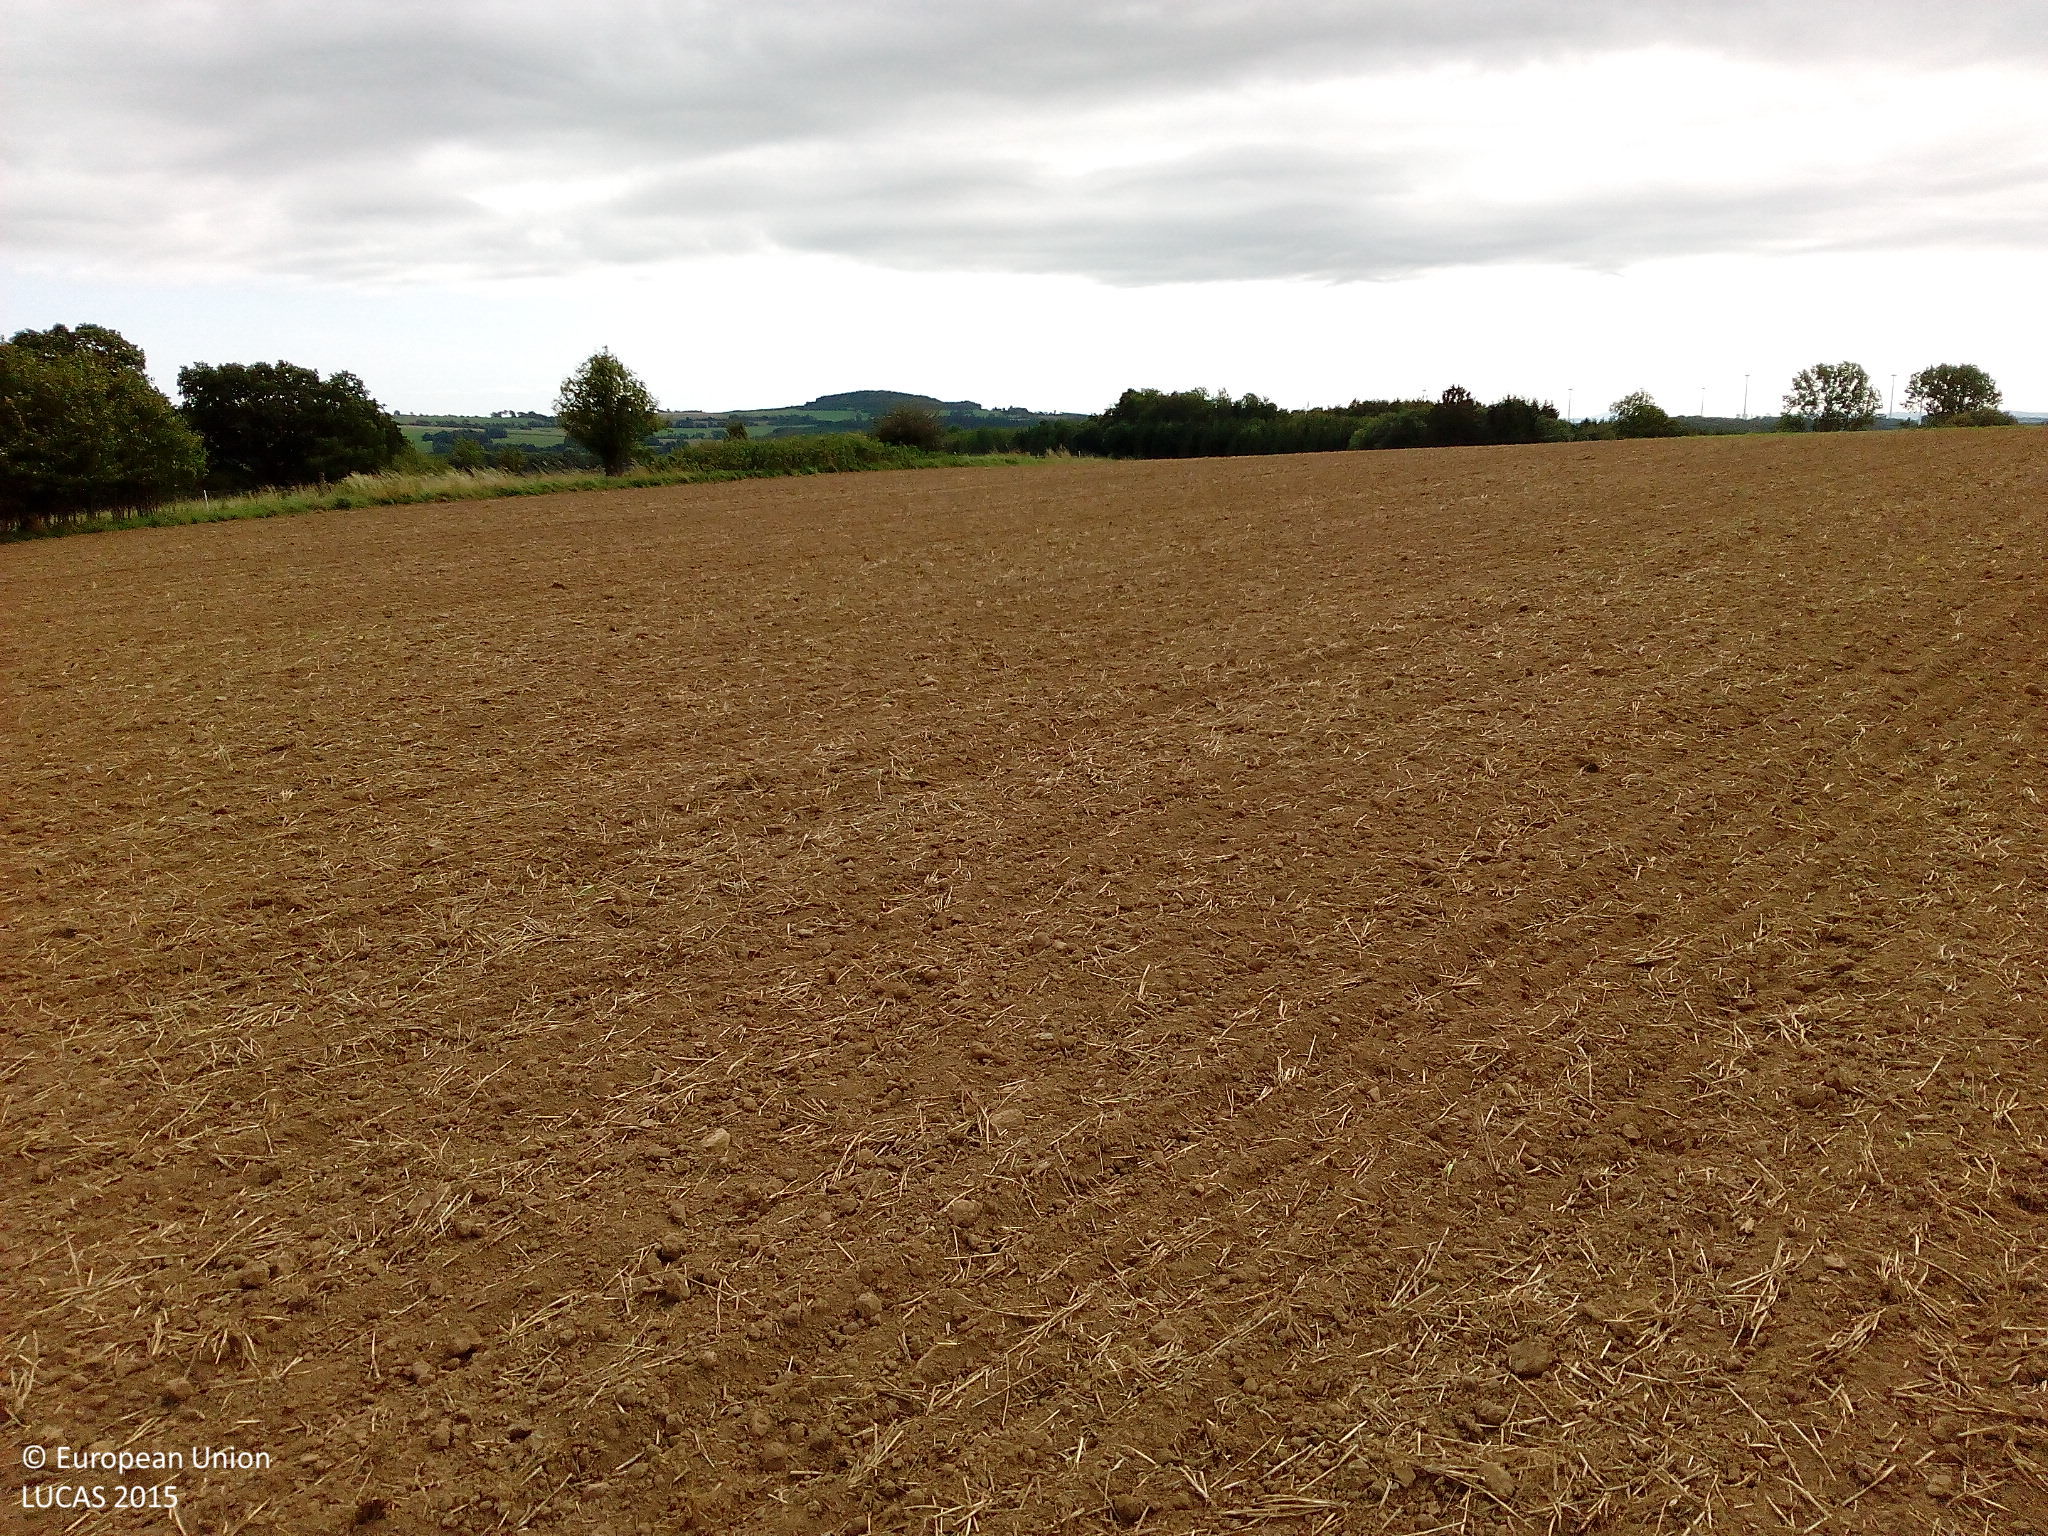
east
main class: Cropland
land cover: Rye
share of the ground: < 10 %
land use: Agriculture (excluding fallow land and kitchen gardens)
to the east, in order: Rye; Grass margins; Abandoned hedges; Fences; Grassland without tree/shrub cover; Fences; Shrubland with sparse tree cover; Fences; Grassland without tree/shrub cover; Fences; Grass margins; Tracks; Broadleaved woodland; Grassland without tree/shrub cover; Mixed cereals for fodder; Grassland without tree/shrub cover; Paved roads, cycling and walking lanes
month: August
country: DE
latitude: 50.4161
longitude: 9.3388
